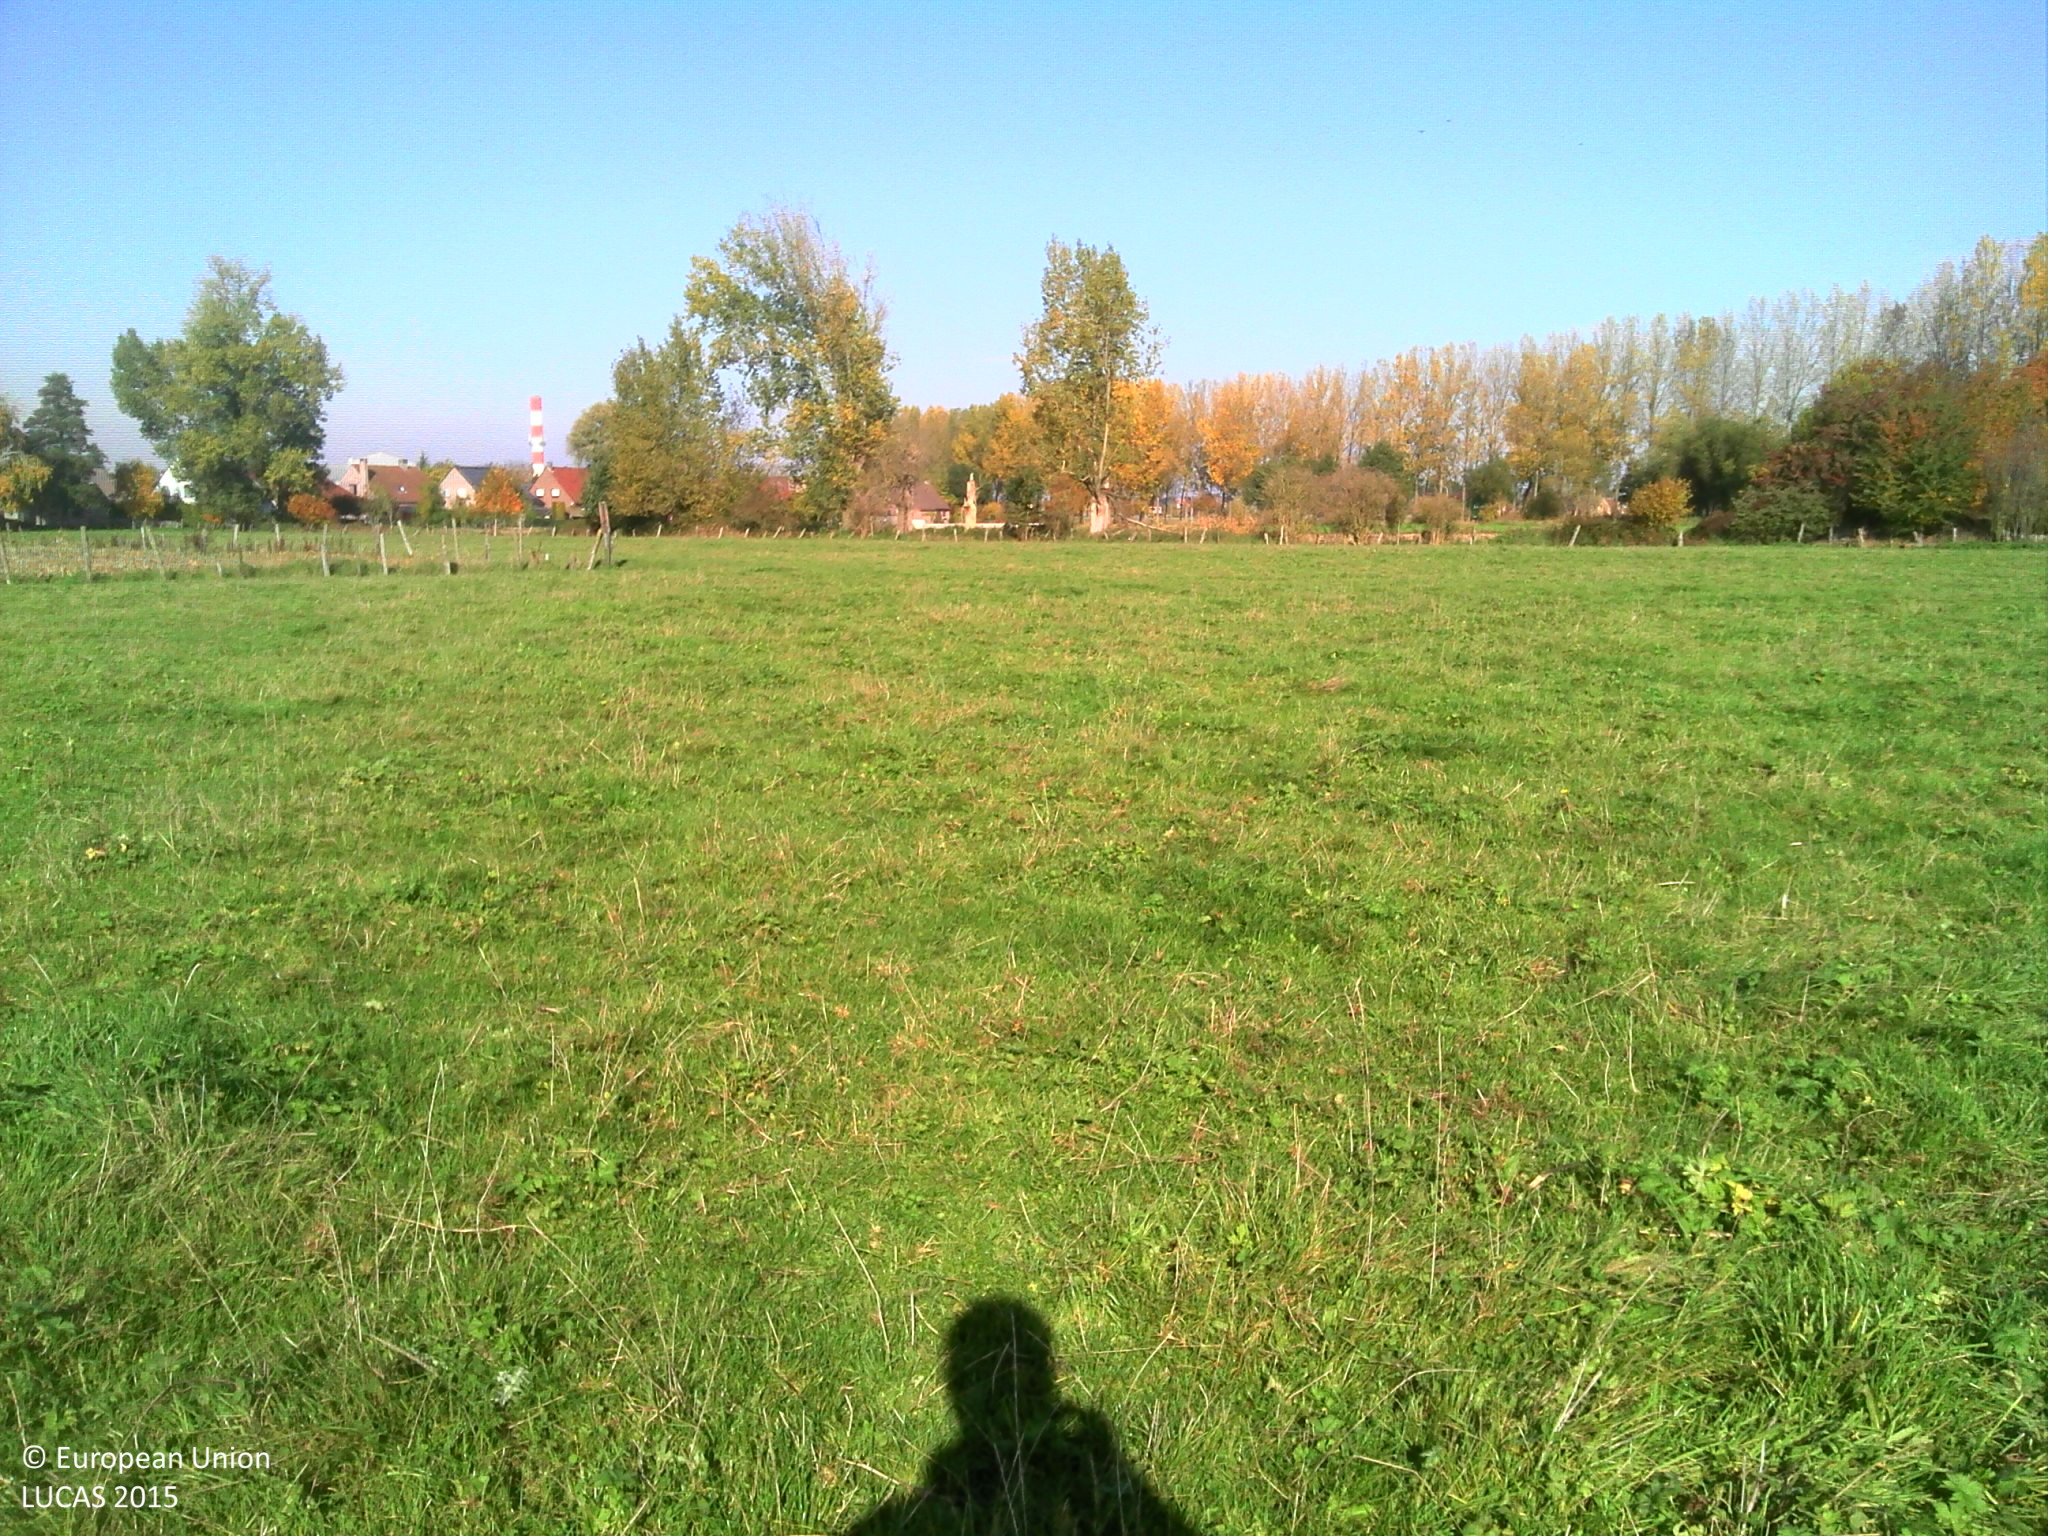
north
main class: Grassland
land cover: Grassland without tree/shrub cover
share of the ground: > 75 %
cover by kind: herbaceous plants 100 %
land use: Agriculture (excluding fallow land and kitchen gardens)
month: October
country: BE
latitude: 51.0003
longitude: 4.3667
